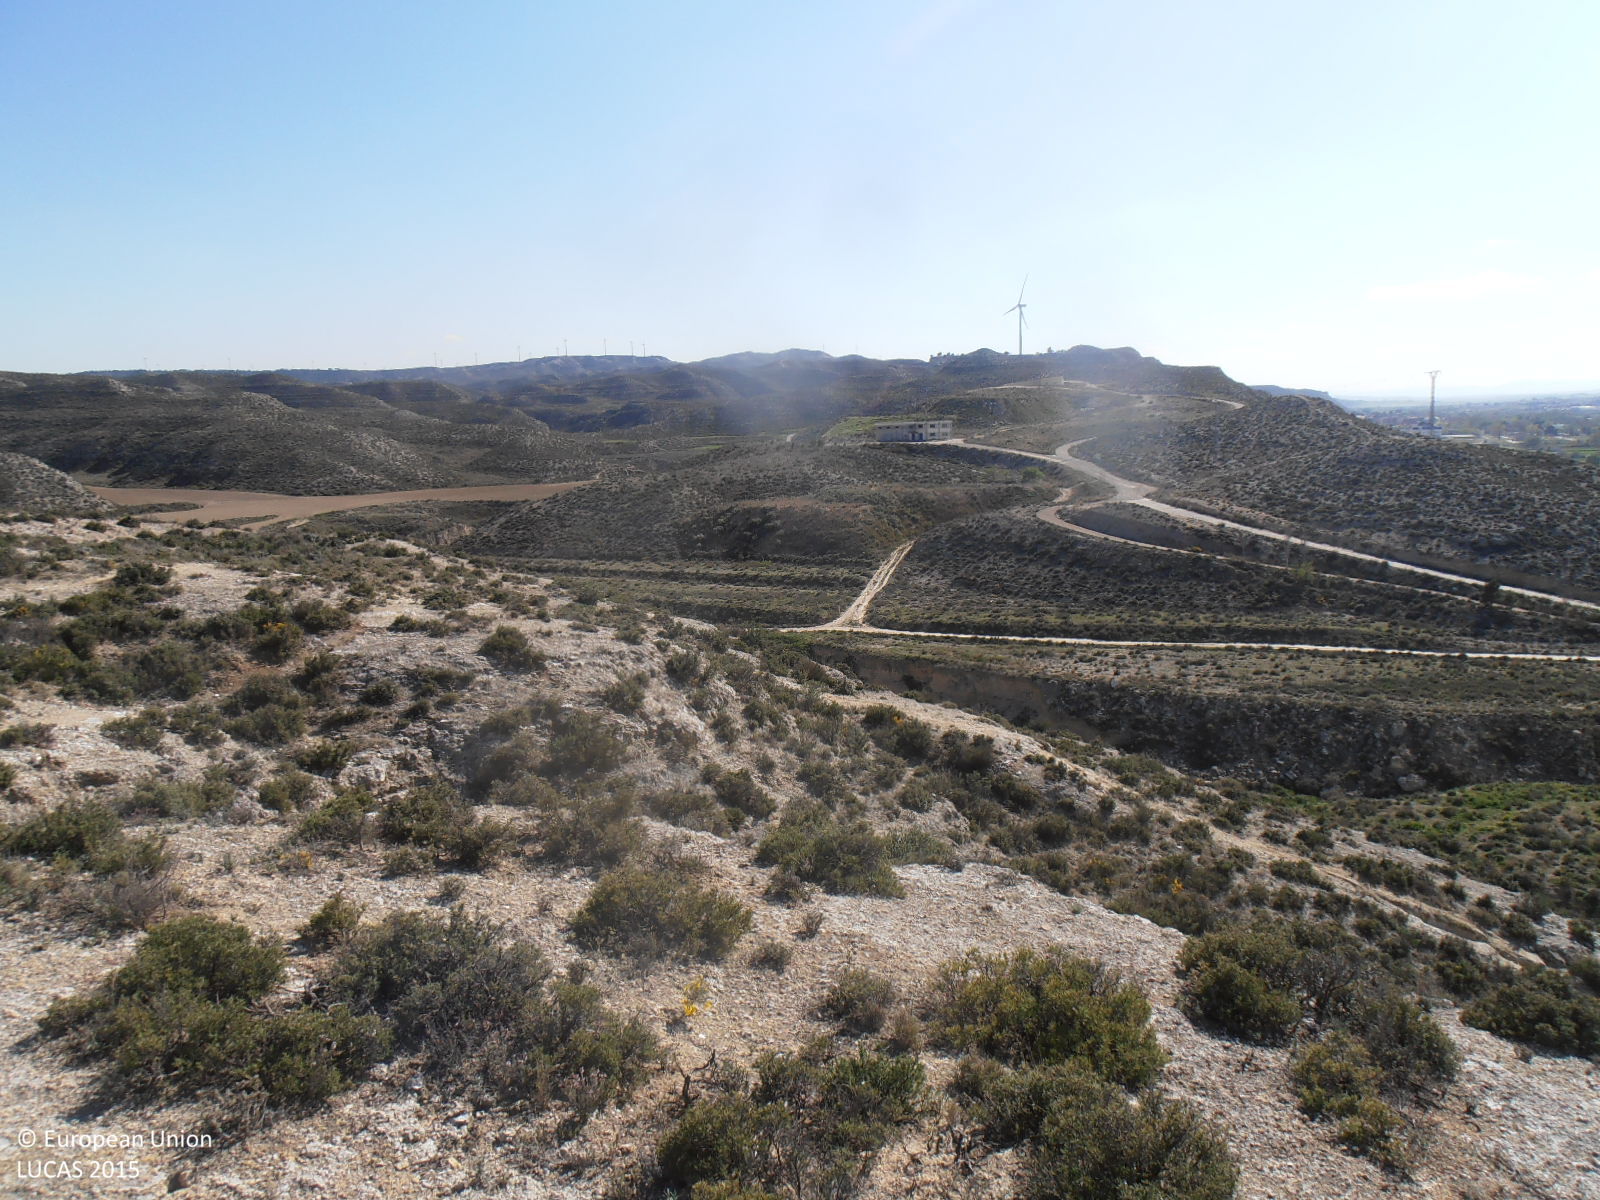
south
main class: Shrubland
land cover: Shrubland without tree cover
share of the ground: > 75 %
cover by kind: consolidated bare surface 75 %, shrubs 25 %
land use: Semi-natural and natural areas not in use
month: April
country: ES
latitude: 41.5672
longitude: -0.9461
